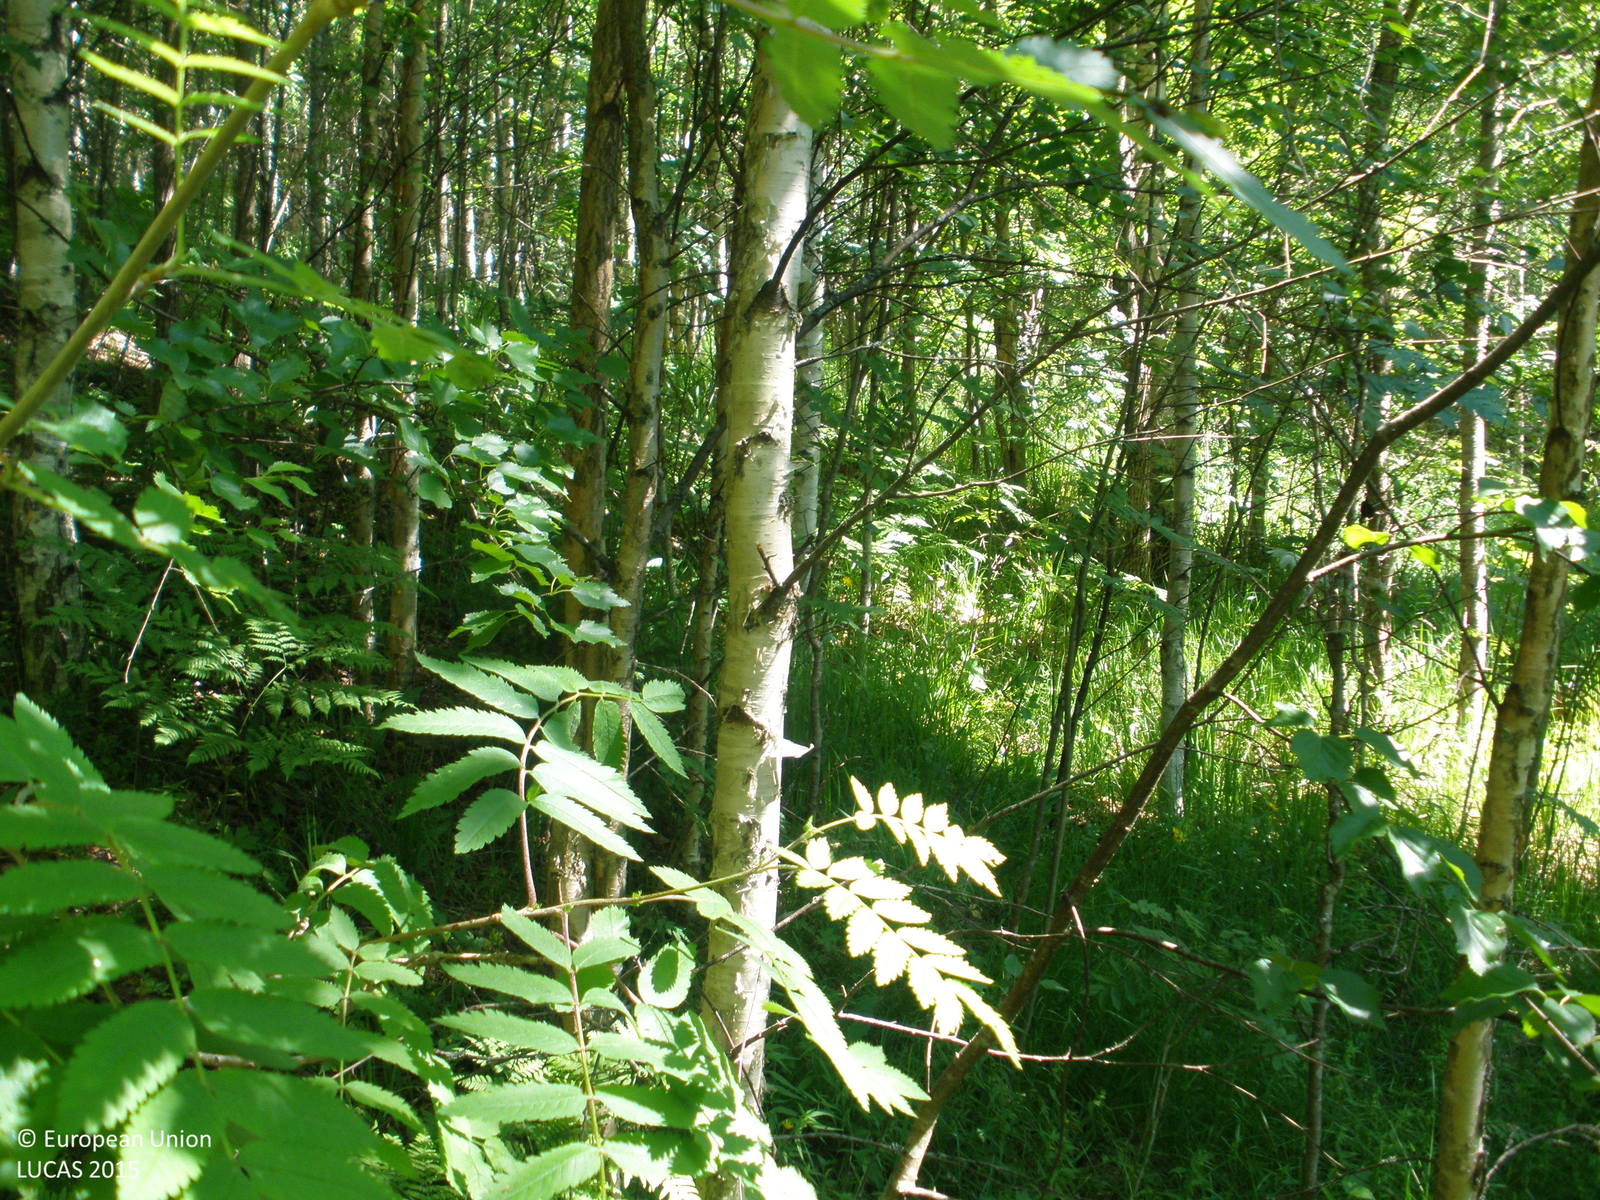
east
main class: Woodland
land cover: Broadleaved woodland
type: non-riverine alder, birch or aspen forest
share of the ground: > 75 %
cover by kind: broadleaved forest trees 85 %, herbaceous plants 15 %
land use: Forestry
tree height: > 5 m
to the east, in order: Broadleaved woodland; Potatoes; Ditches and canals; Electric lines; Grass margins; Tracks; Ditches and canals; Electric lines; Spruce dominated mixed woodland; Ditches and canals; Grass margins; Tracks; Broadleaved woodland; Spruce dominated mixed woodland
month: July
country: FI
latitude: 61.0401
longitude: 23.7697
